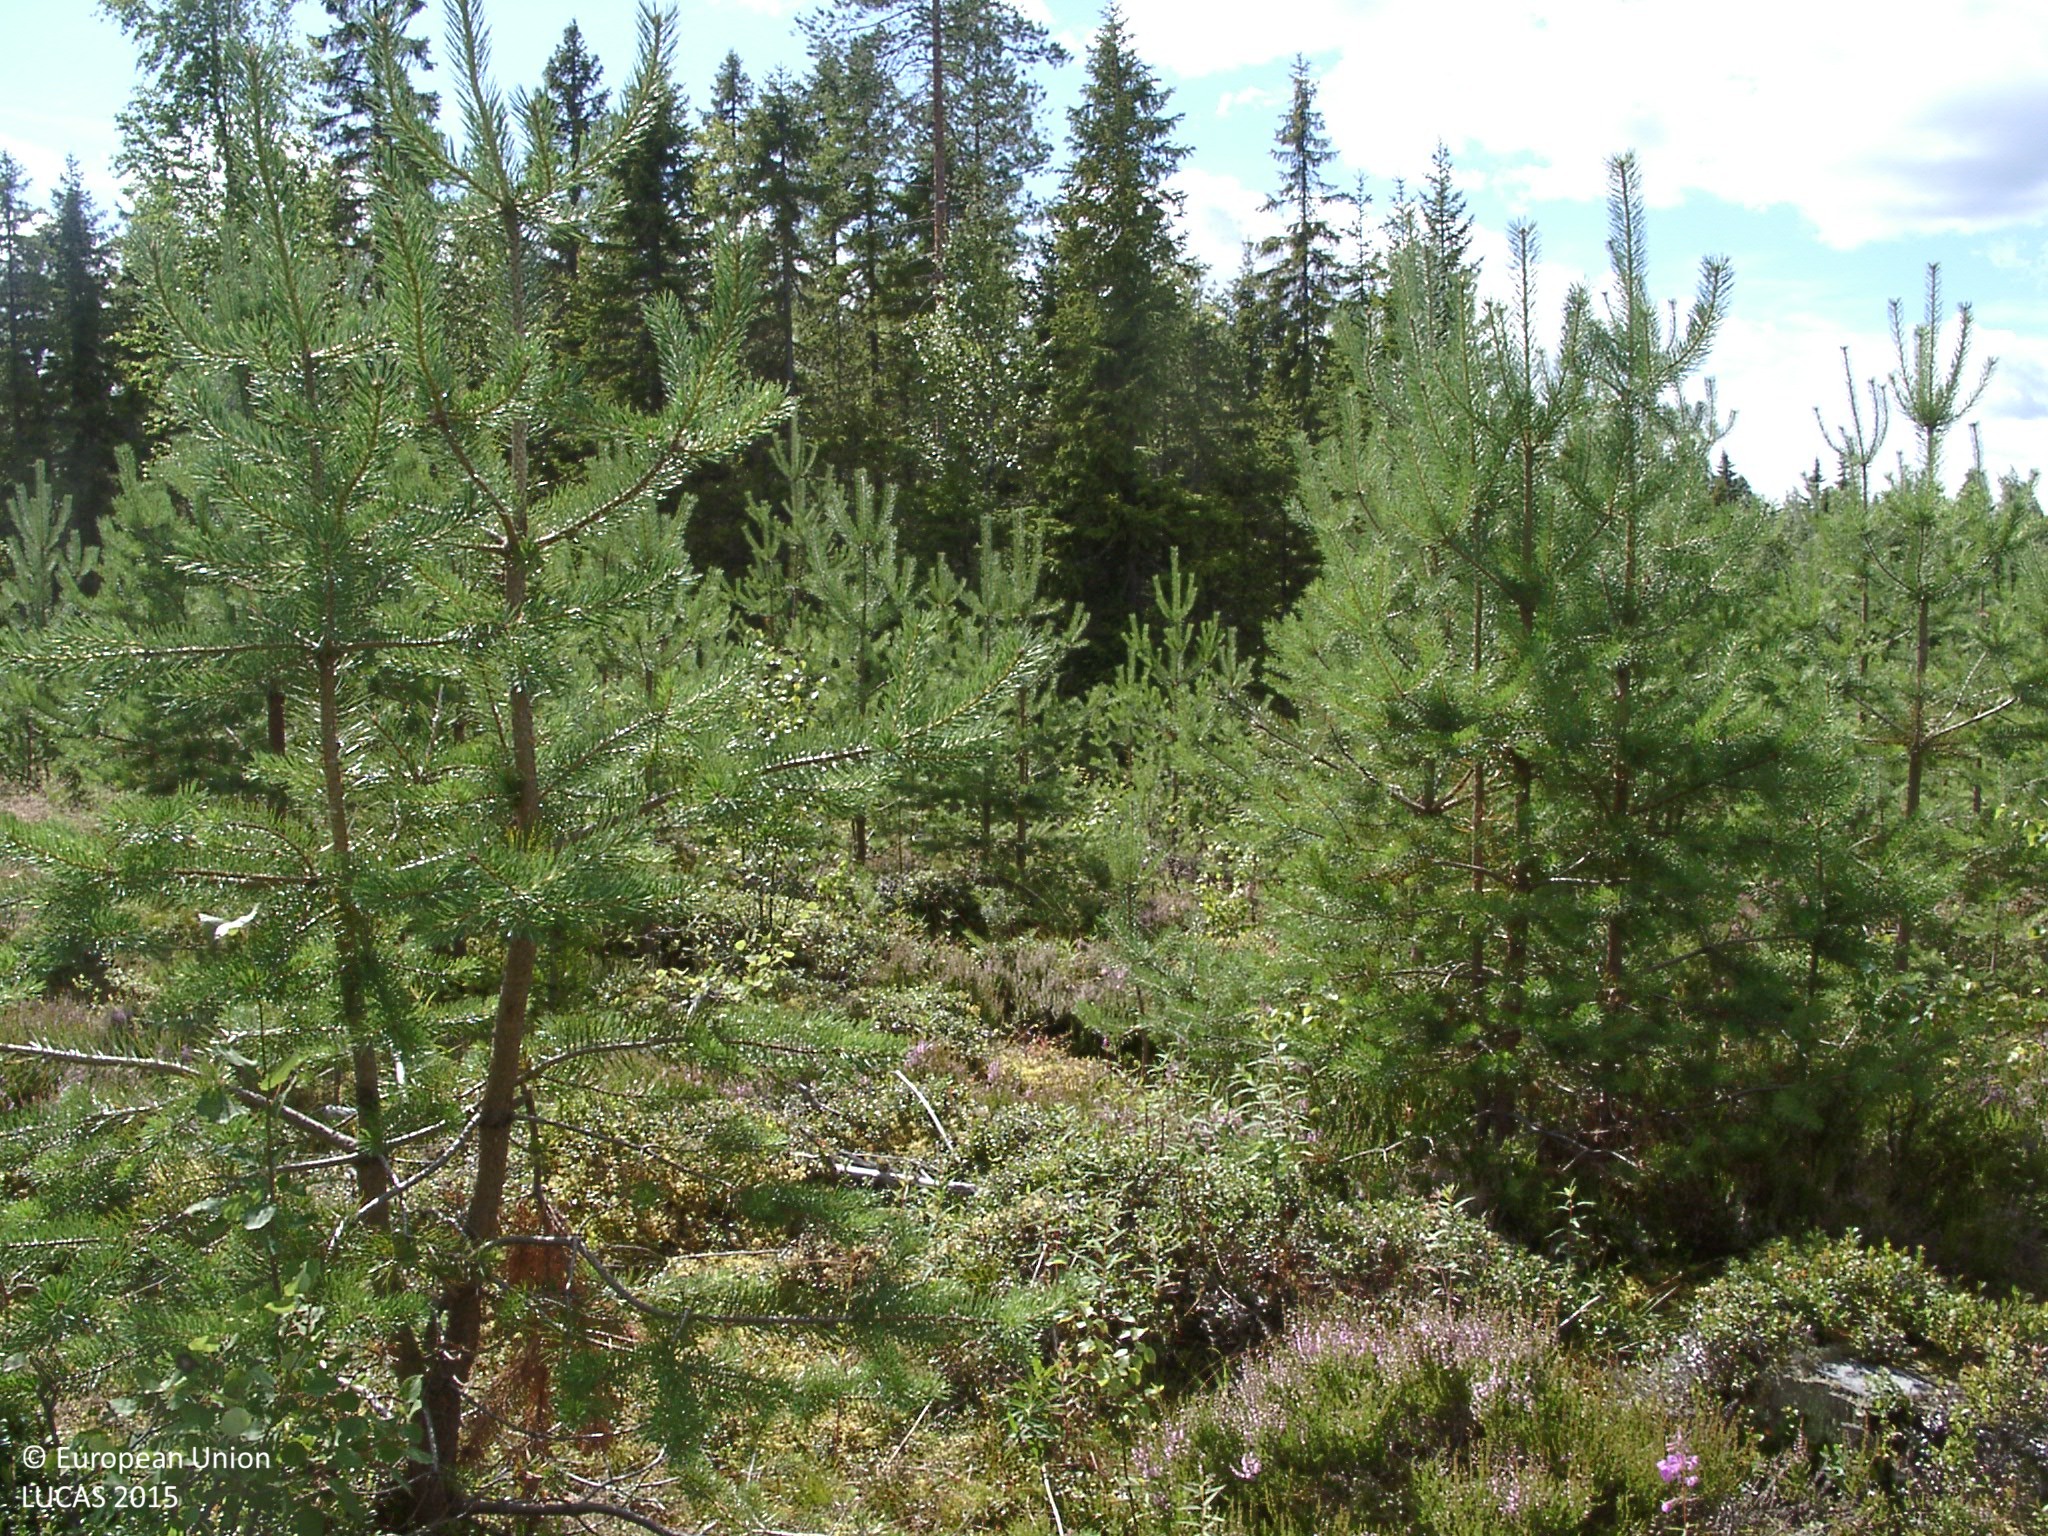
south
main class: Woodland
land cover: Pine dominated coniferous woodland
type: boreal forest
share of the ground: 25 - 50 %
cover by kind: coniferous forest trees 40 %, shrubs 35 %, lichens and mosses 15 %, broadleaved forest trees 5 %, herbaceous plants 5 %
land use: Forestry
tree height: < 5 m
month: August
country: FI
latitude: 62.9996
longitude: 24.5983
